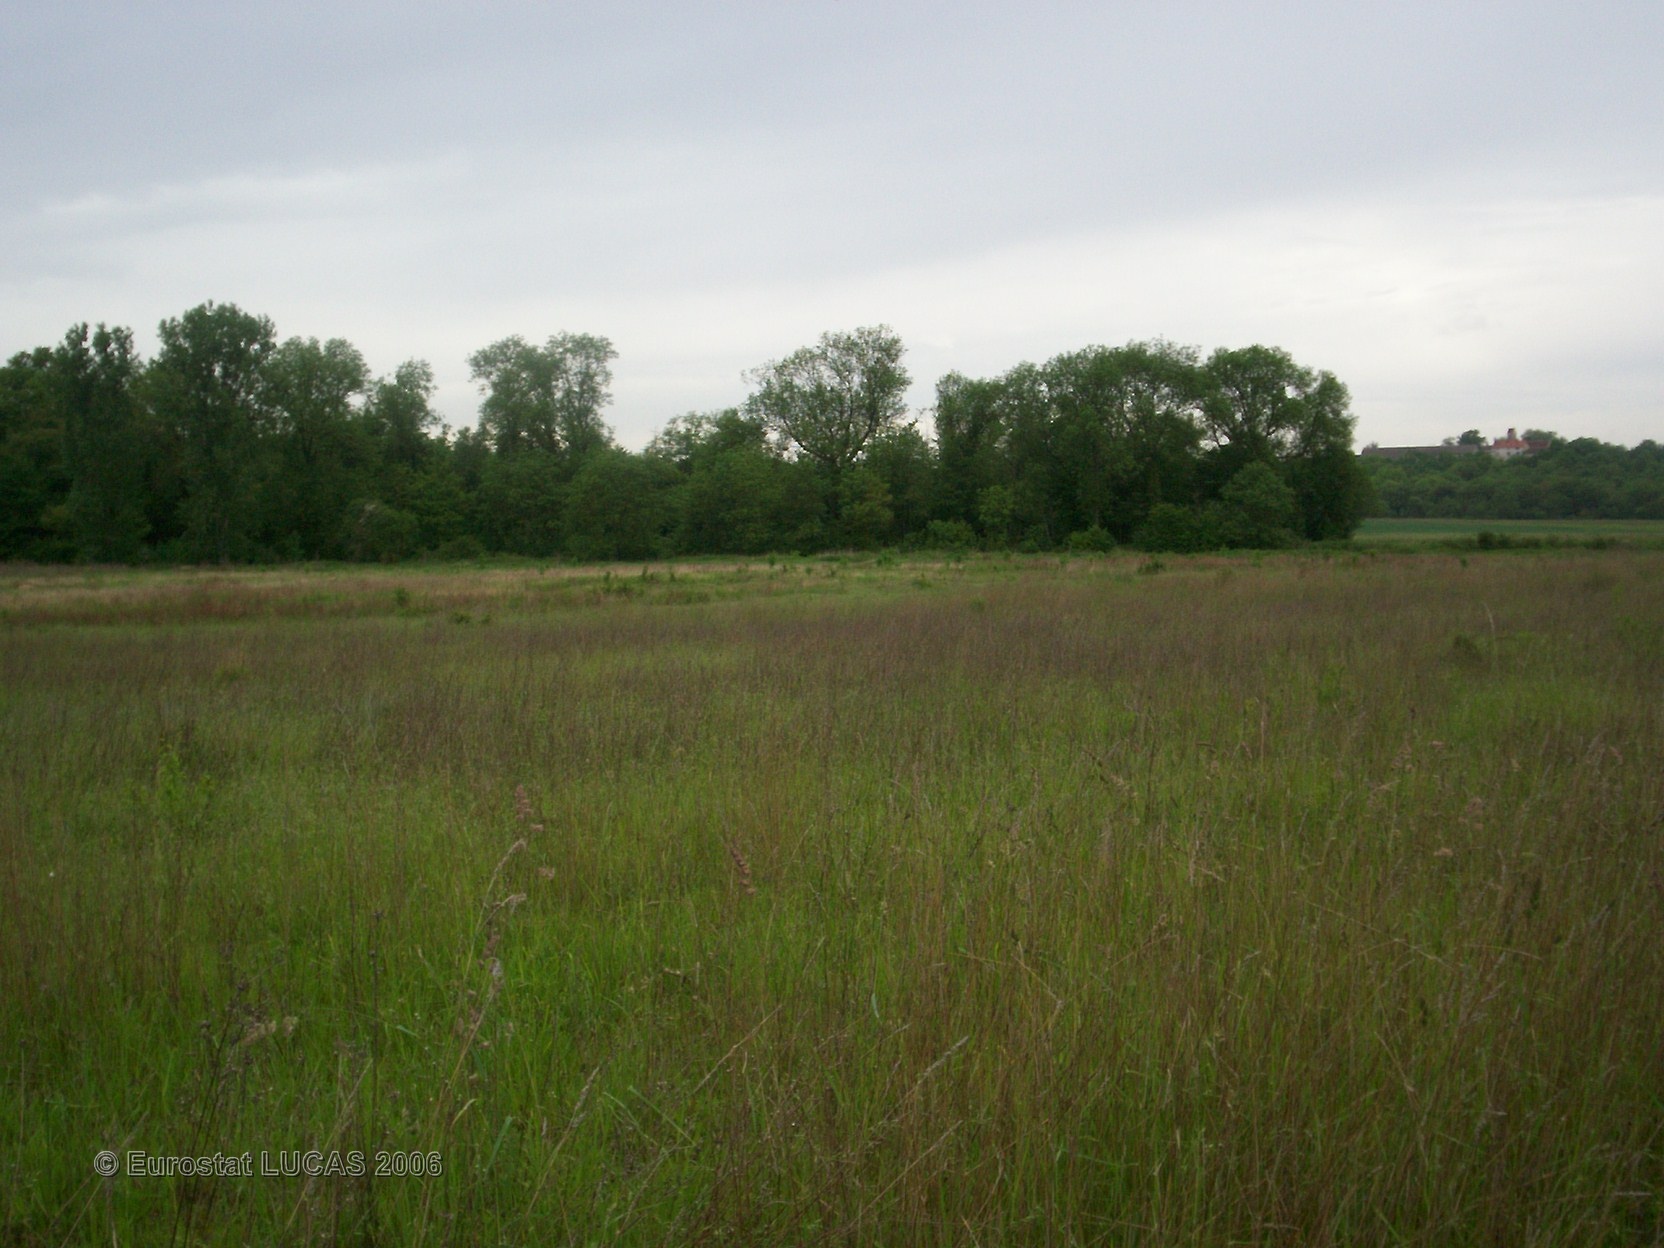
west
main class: Grassland
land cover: Grassland without tree/shrub cover
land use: Fallow land
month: May
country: FR
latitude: 48.6516
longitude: 2.7280
